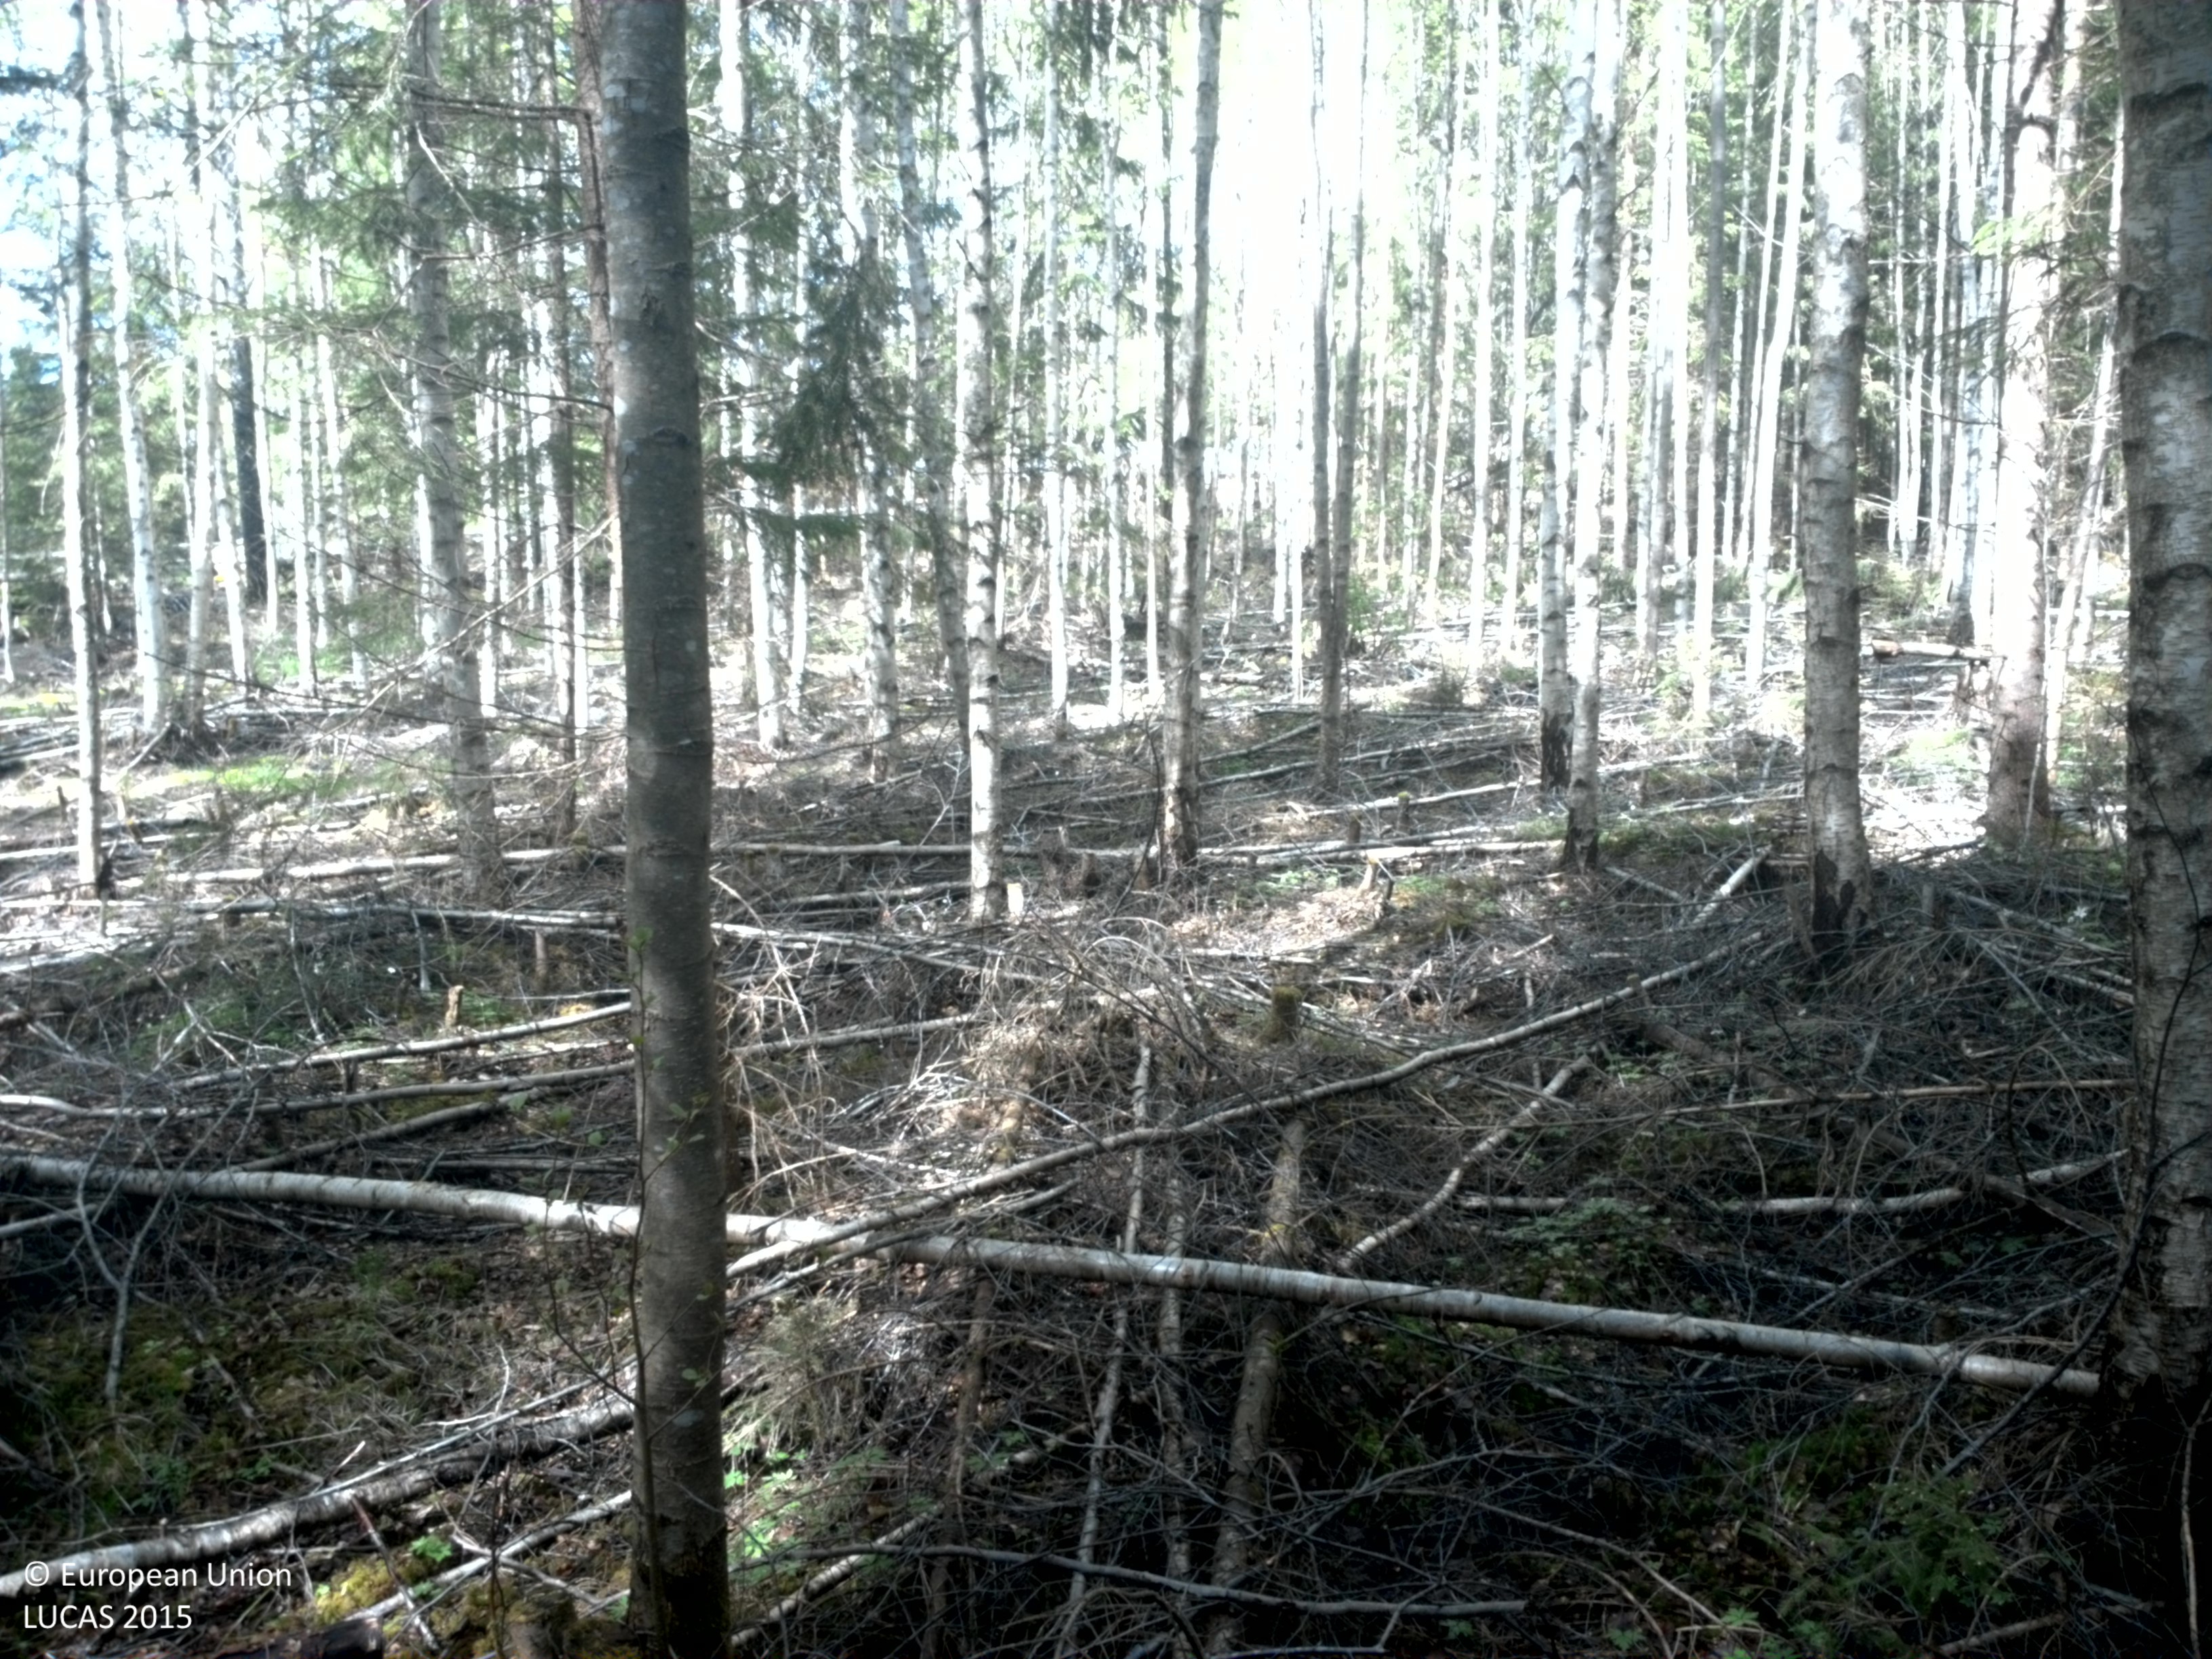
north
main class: Woodland
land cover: Broadleaved woodland
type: boreal forest
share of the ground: > 75 %
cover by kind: broadleaved forest trees 95 %, coniferous forest trees 5 %
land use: Forestry
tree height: > 5 m
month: May
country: SE
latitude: 59.5297
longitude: 12.4159
